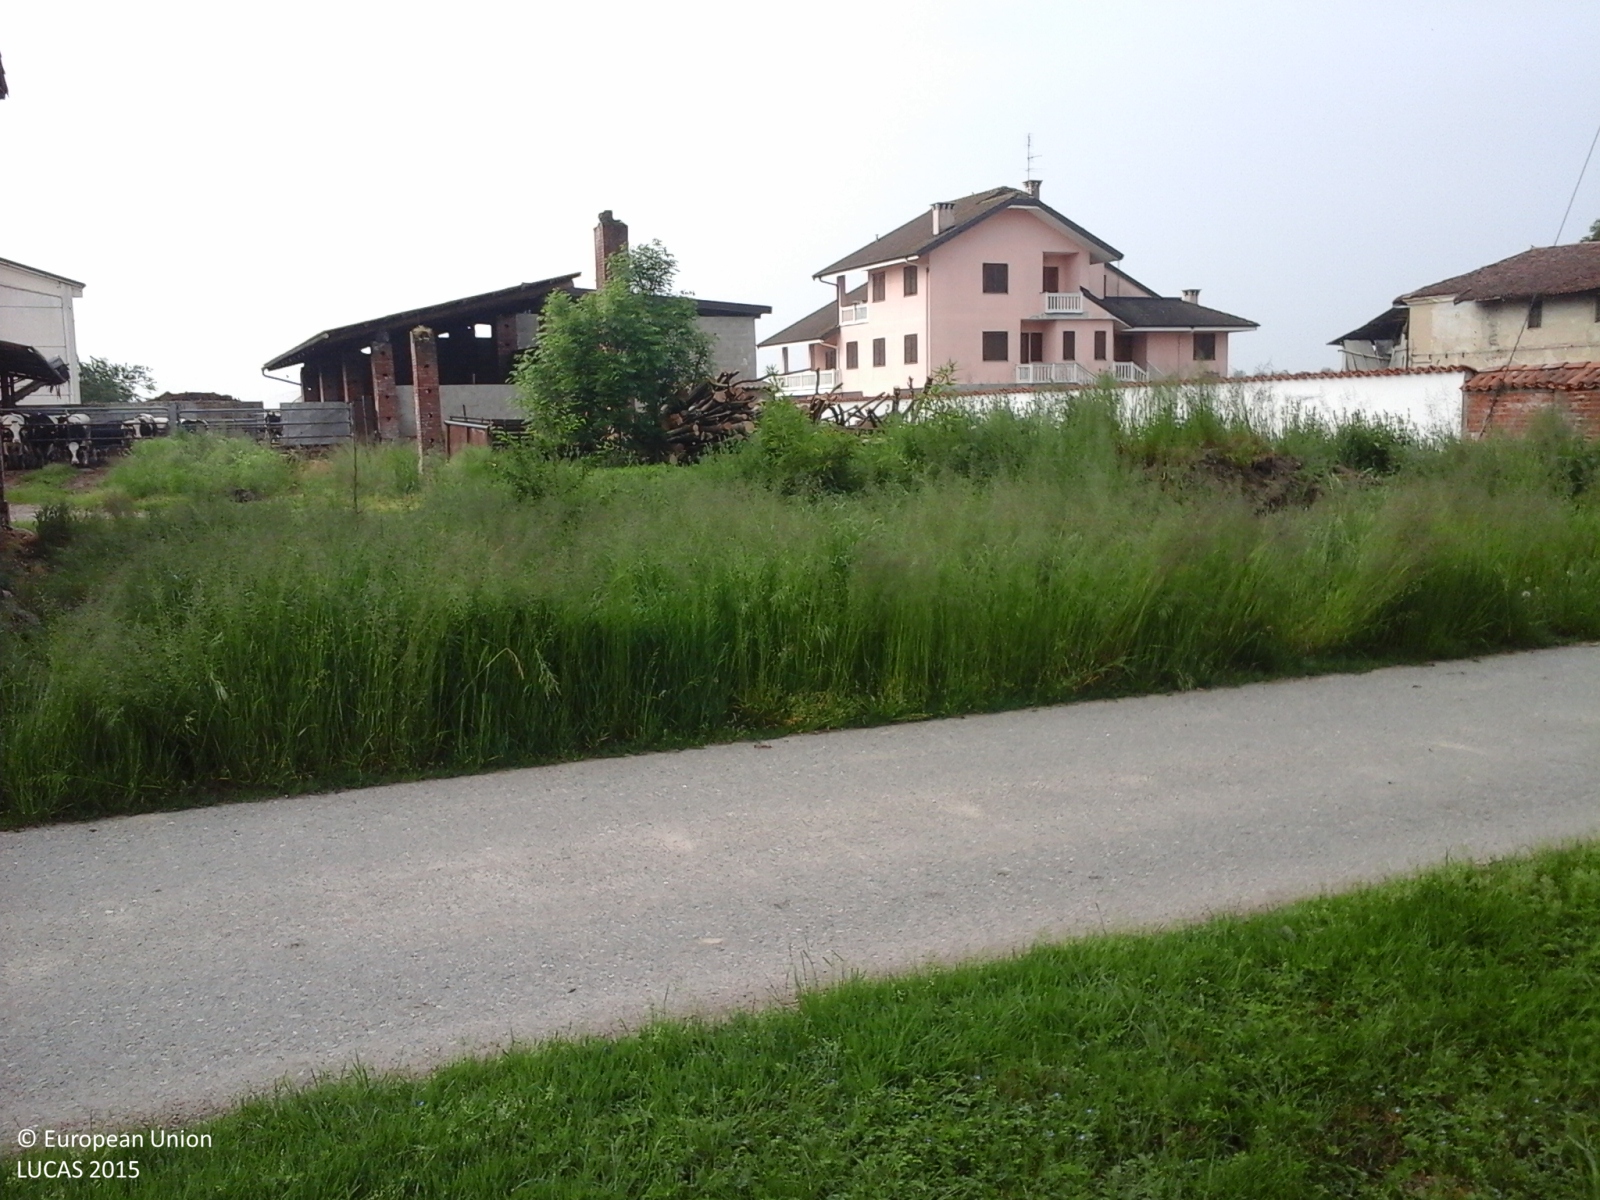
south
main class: Cropland
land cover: Temporary grasslands
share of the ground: > 75 %
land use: Agriculture (excluding fallow land and kitchen gardens)
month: May
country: IT
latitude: 44.6317
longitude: 7.6978
